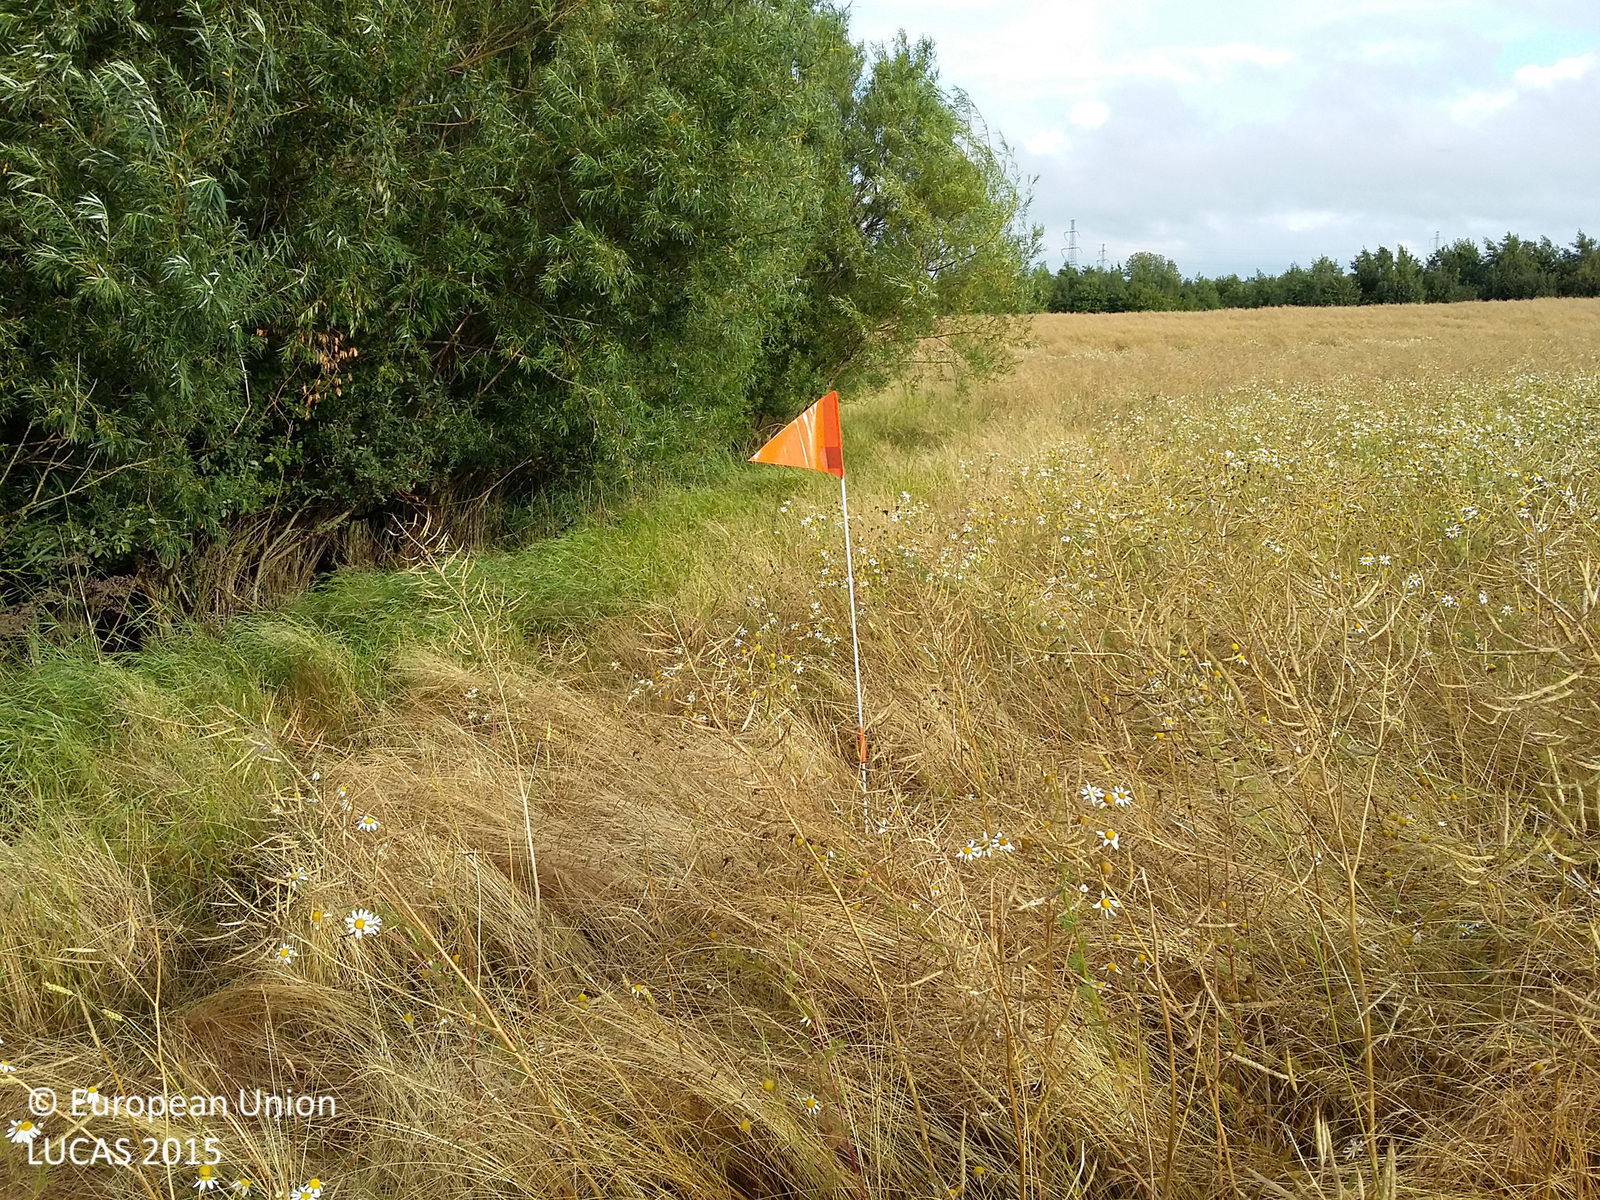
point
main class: Cropland
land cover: Rape and turnip rape
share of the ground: > 75 %
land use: Agriculture (excluding fallow land and kitchen gardens)
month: July
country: DK
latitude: 55.8640
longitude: 12.1551
